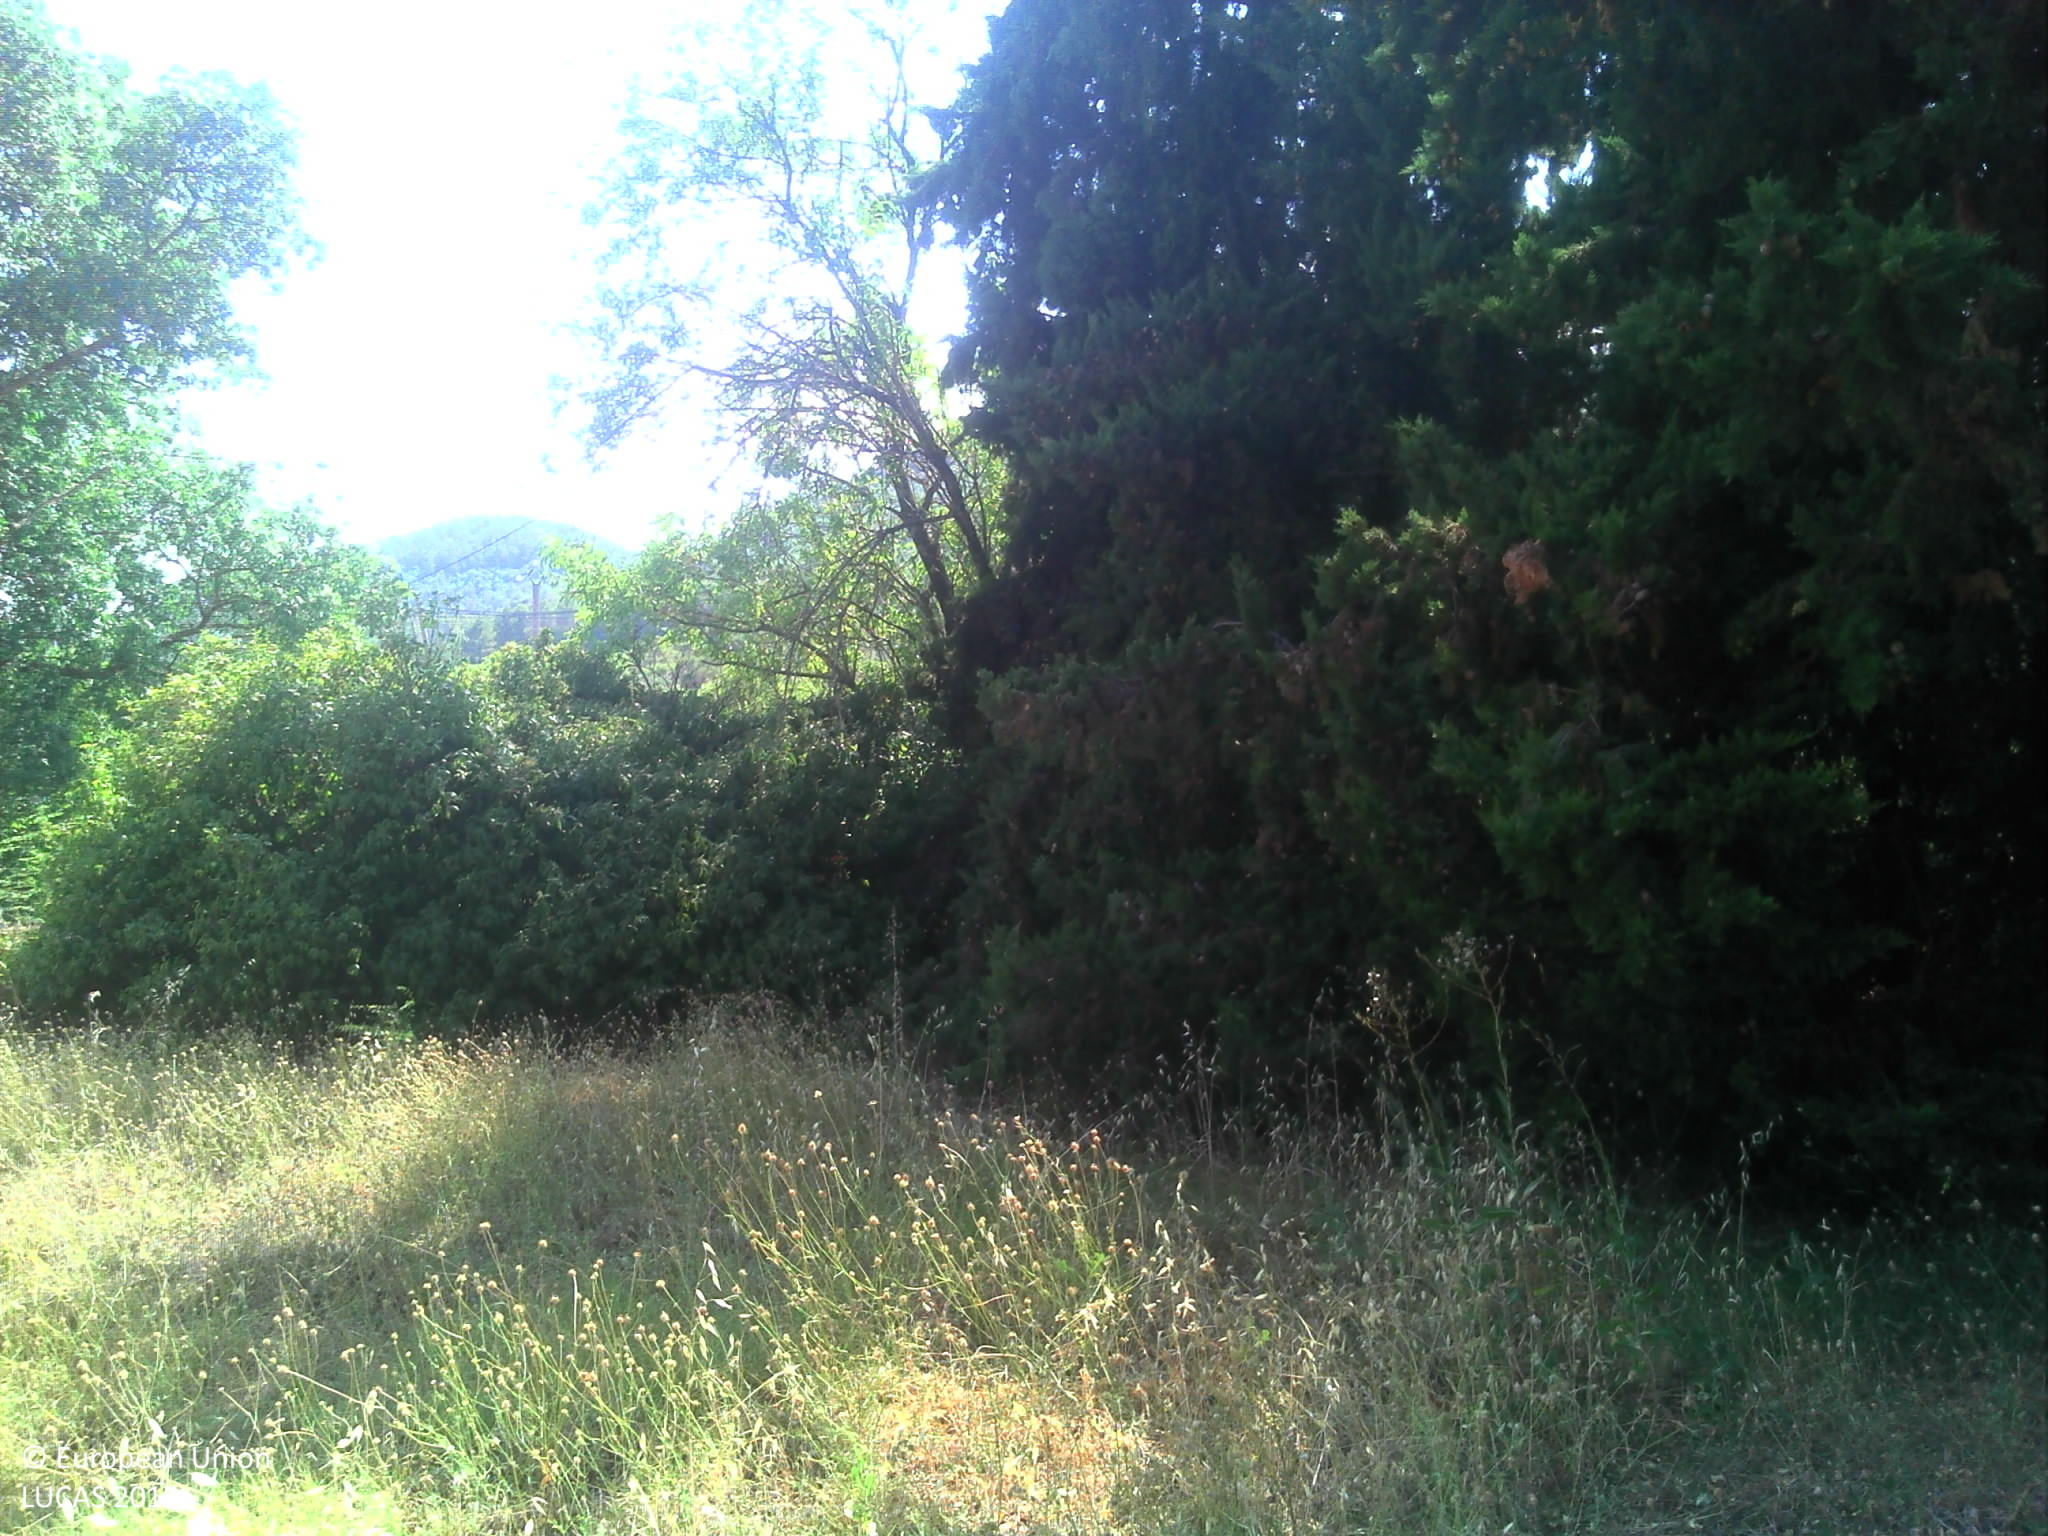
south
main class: Cropland
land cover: Nuts trees
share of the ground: < 10 %
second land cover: Grassland without tree/shrub cover
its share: > 75 %
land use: Kitchen garden
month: July
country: FR
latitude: 43.3634
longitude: 6.2949
